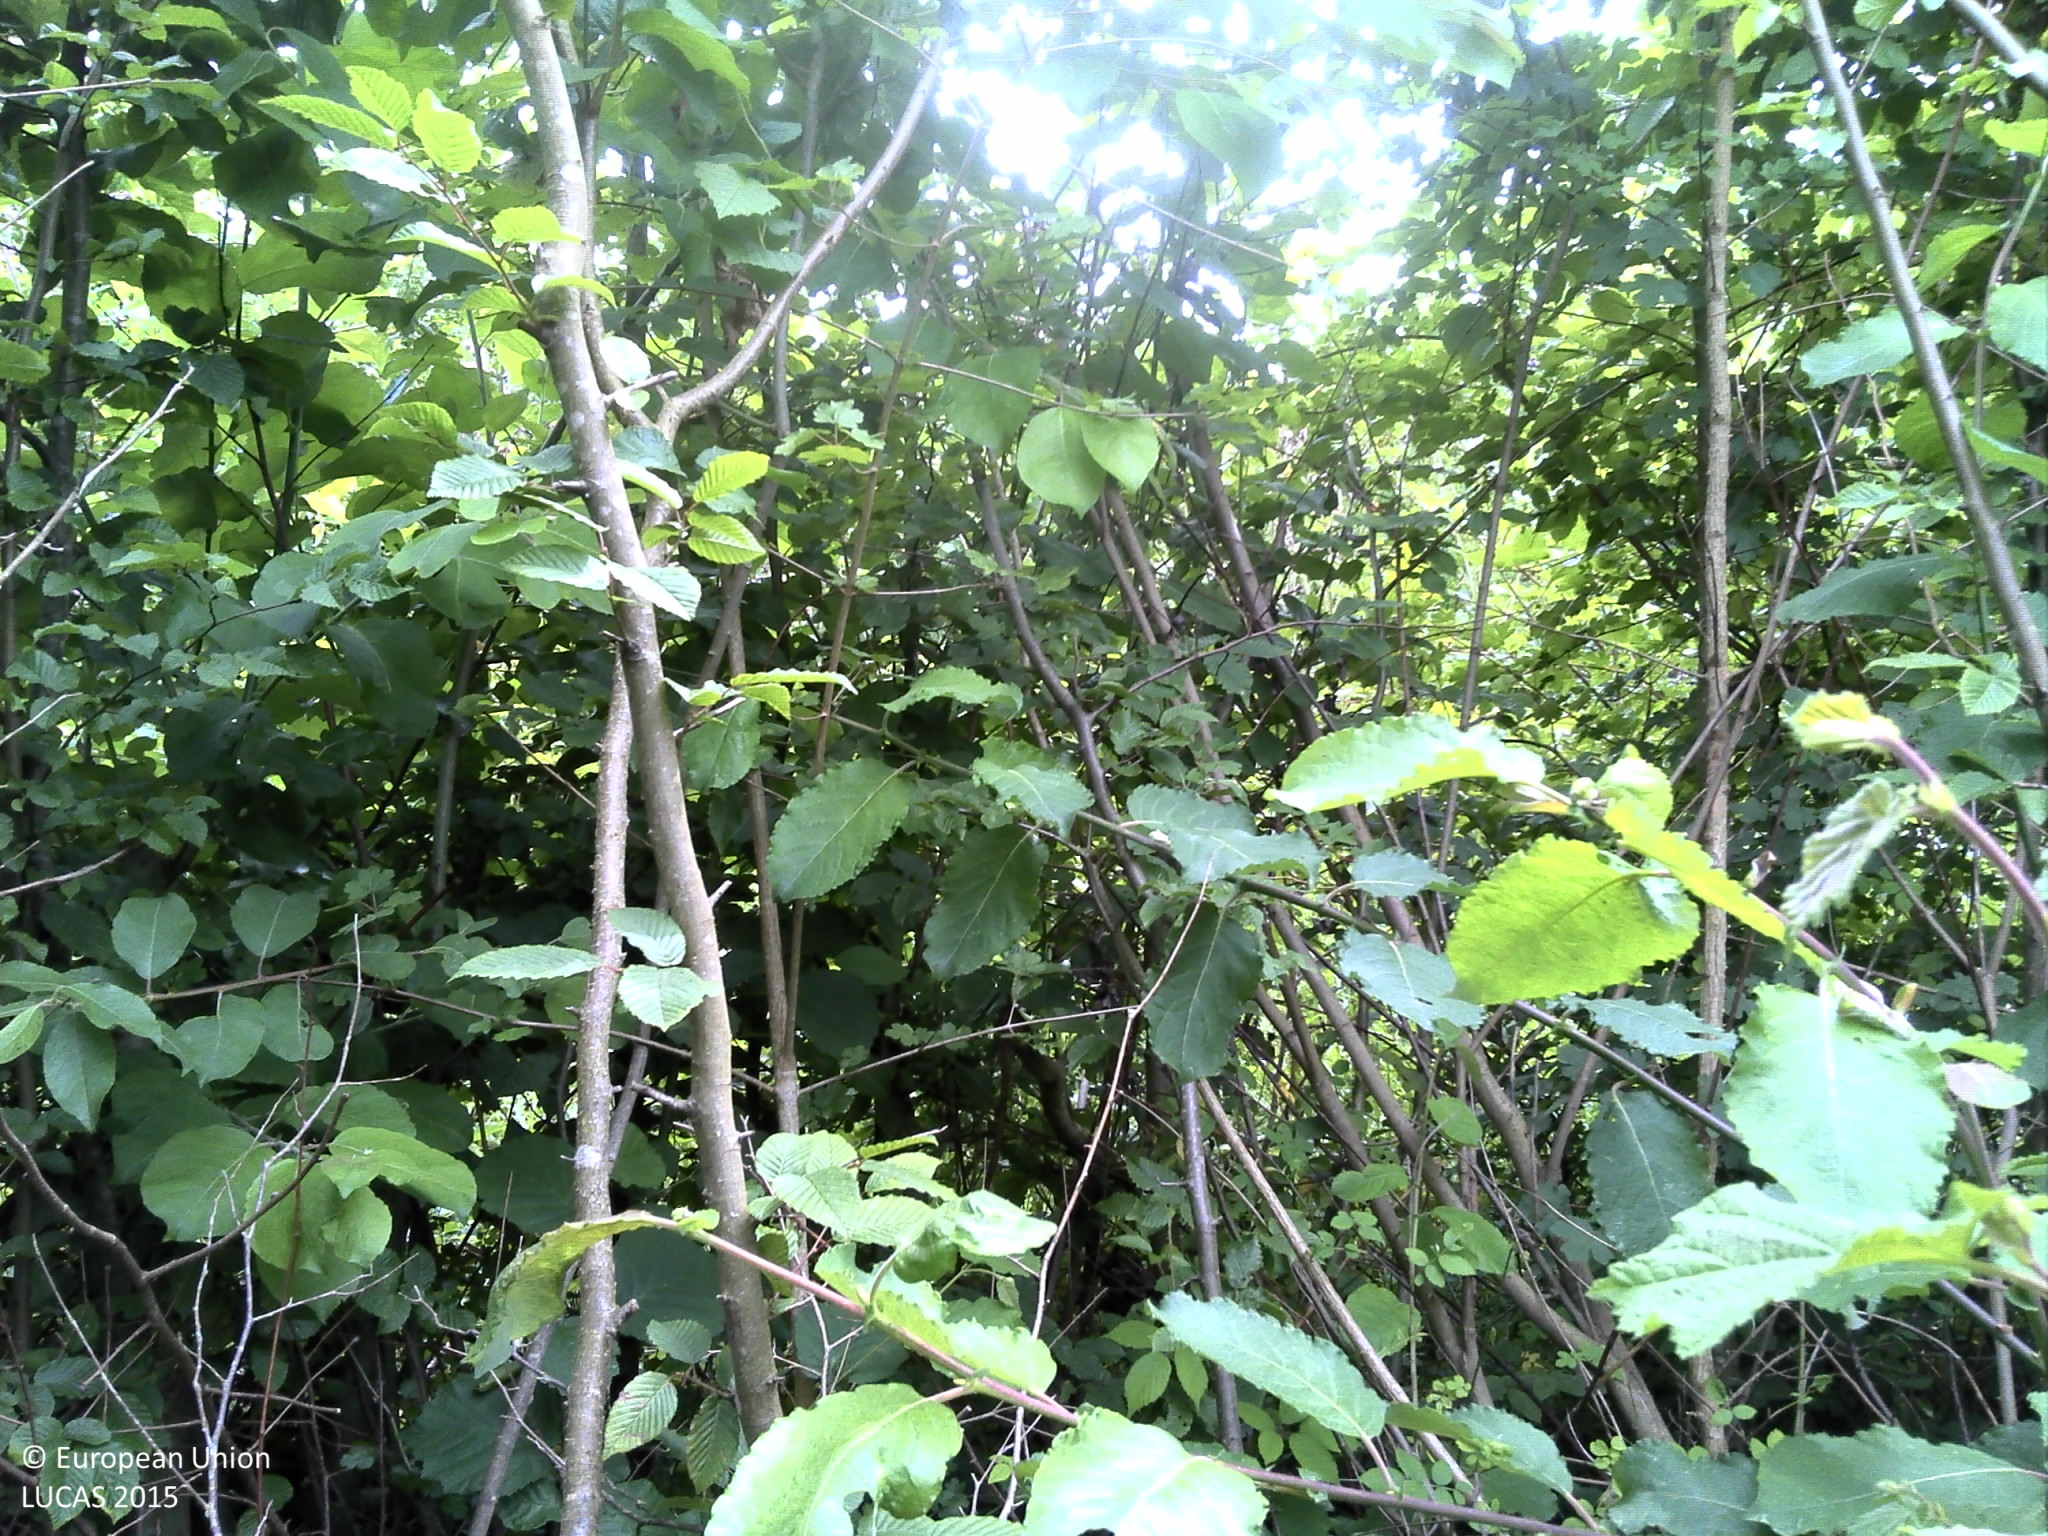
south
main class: Woodland
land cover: Broadleaved woodland
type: mesophytic deciduous forest
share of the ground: > 75 %
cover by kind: broadleaved forest trees 70 %, herbaceous plants 30 %
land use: Forestry
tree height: > 5 m
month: June
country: FR
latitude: 49.2754
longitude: 6.2198
